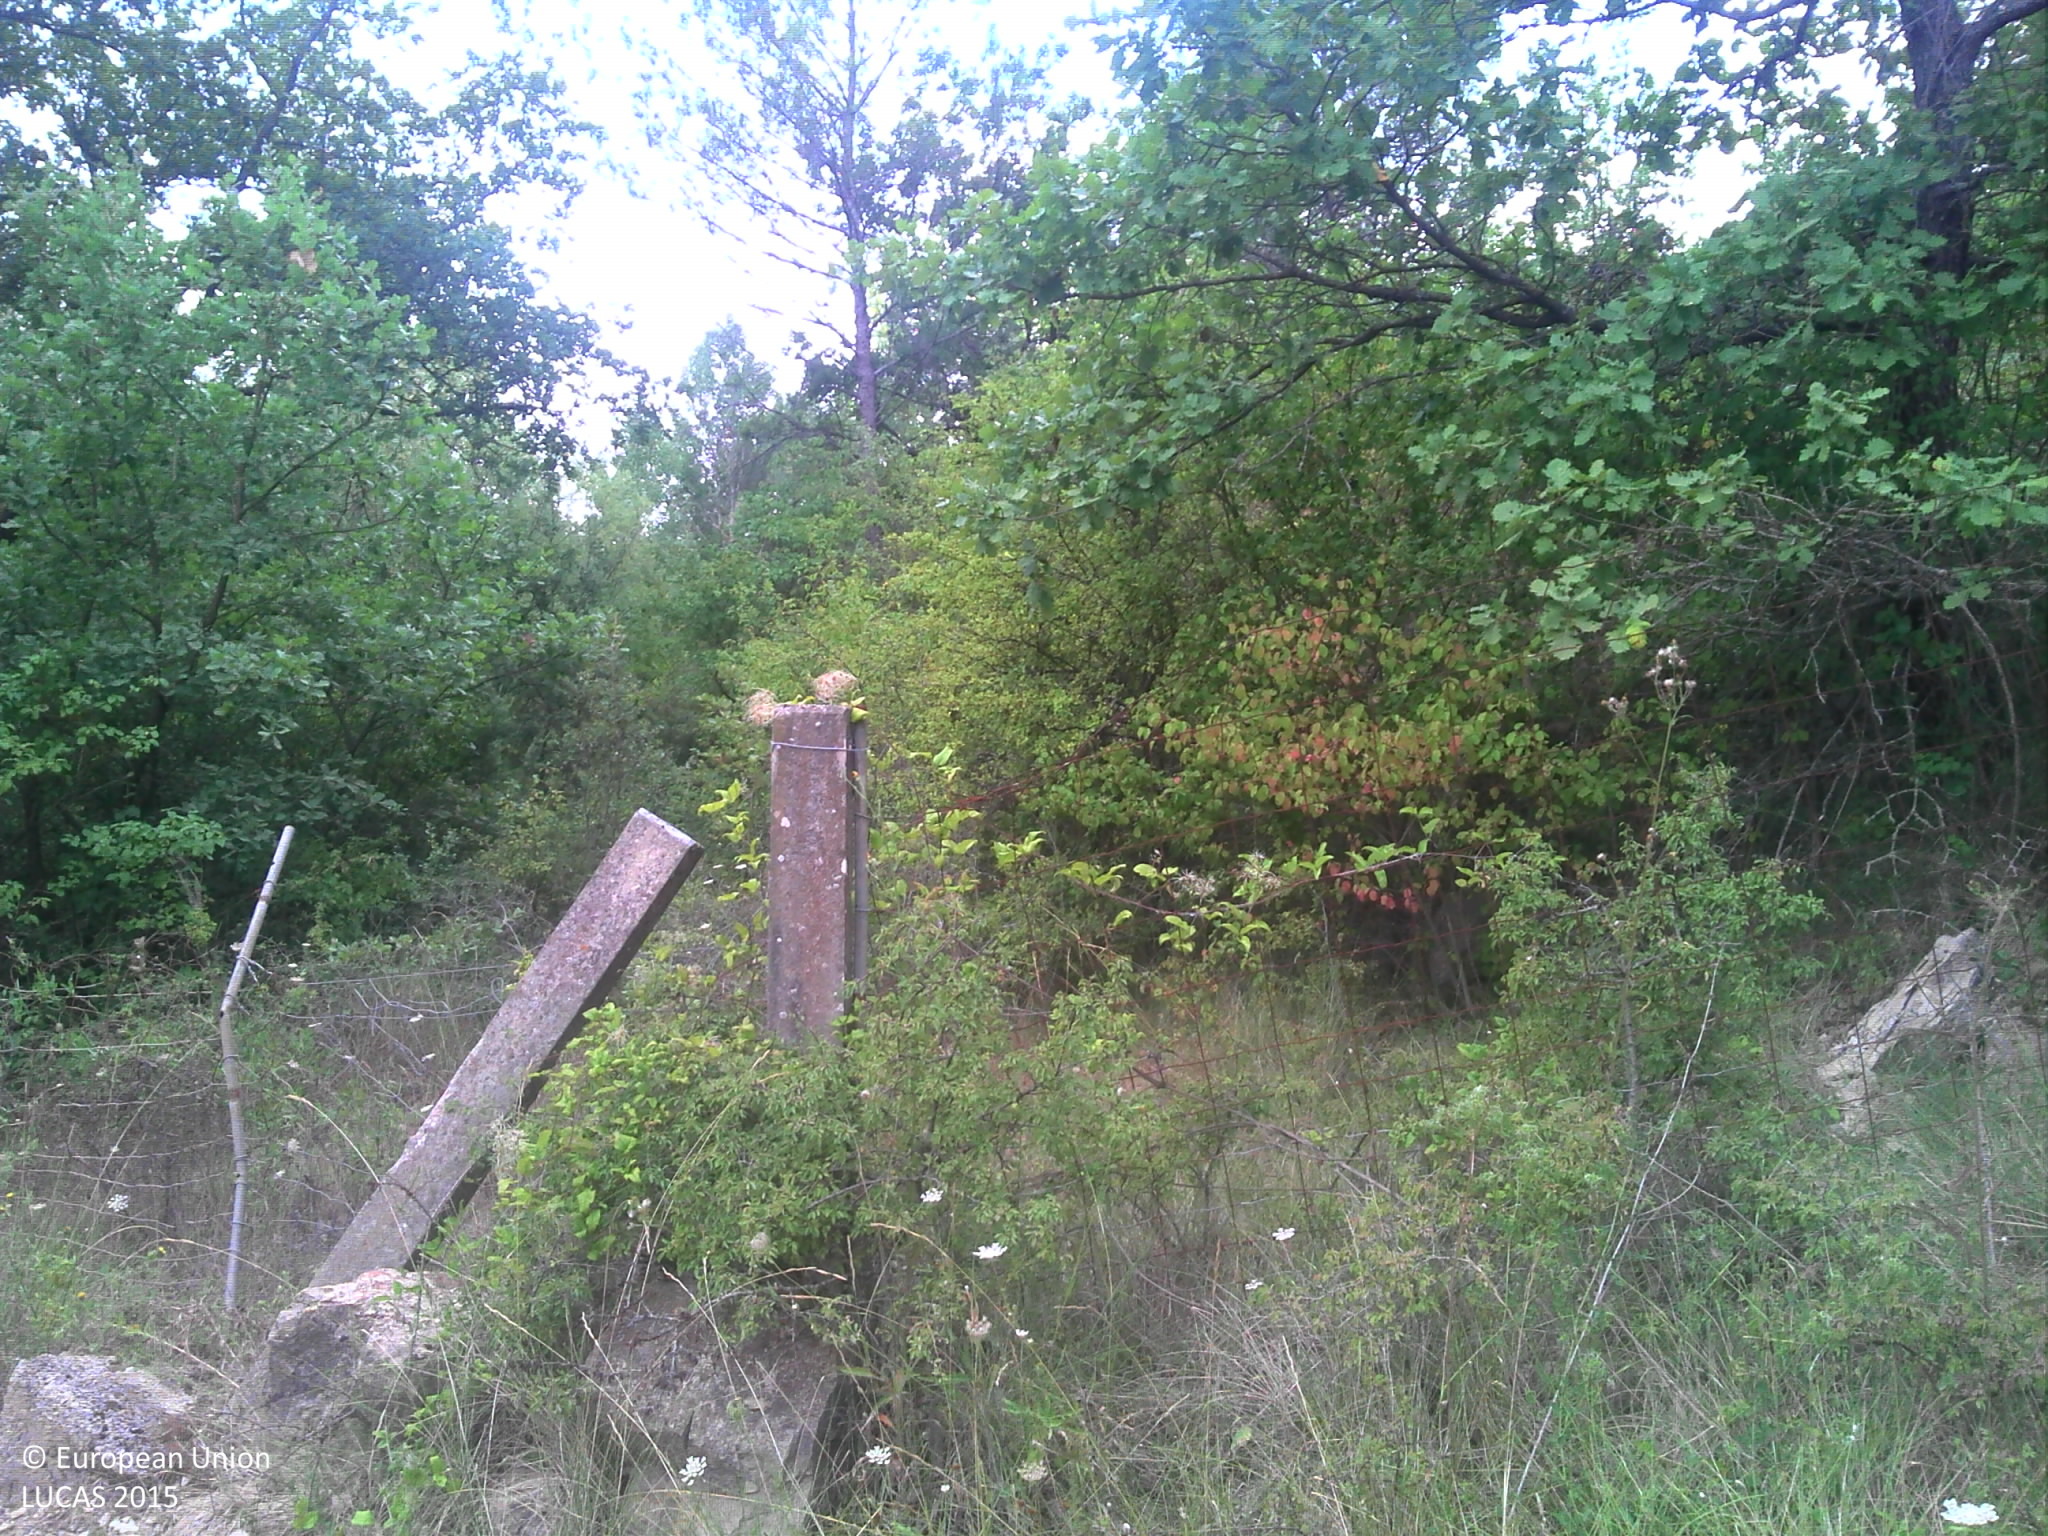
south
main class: Woodland
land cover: Pine dominated mixed woodland
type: coniferous forest of the mediterranean region
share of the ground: > 75 %
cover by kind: coniferous forest trees 45 %, broadleaved forest trees 30 %, shrubs 25 %
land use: Sport
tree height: < 5 m
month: August
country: FR
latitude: 43.4251
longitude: 5.5754
